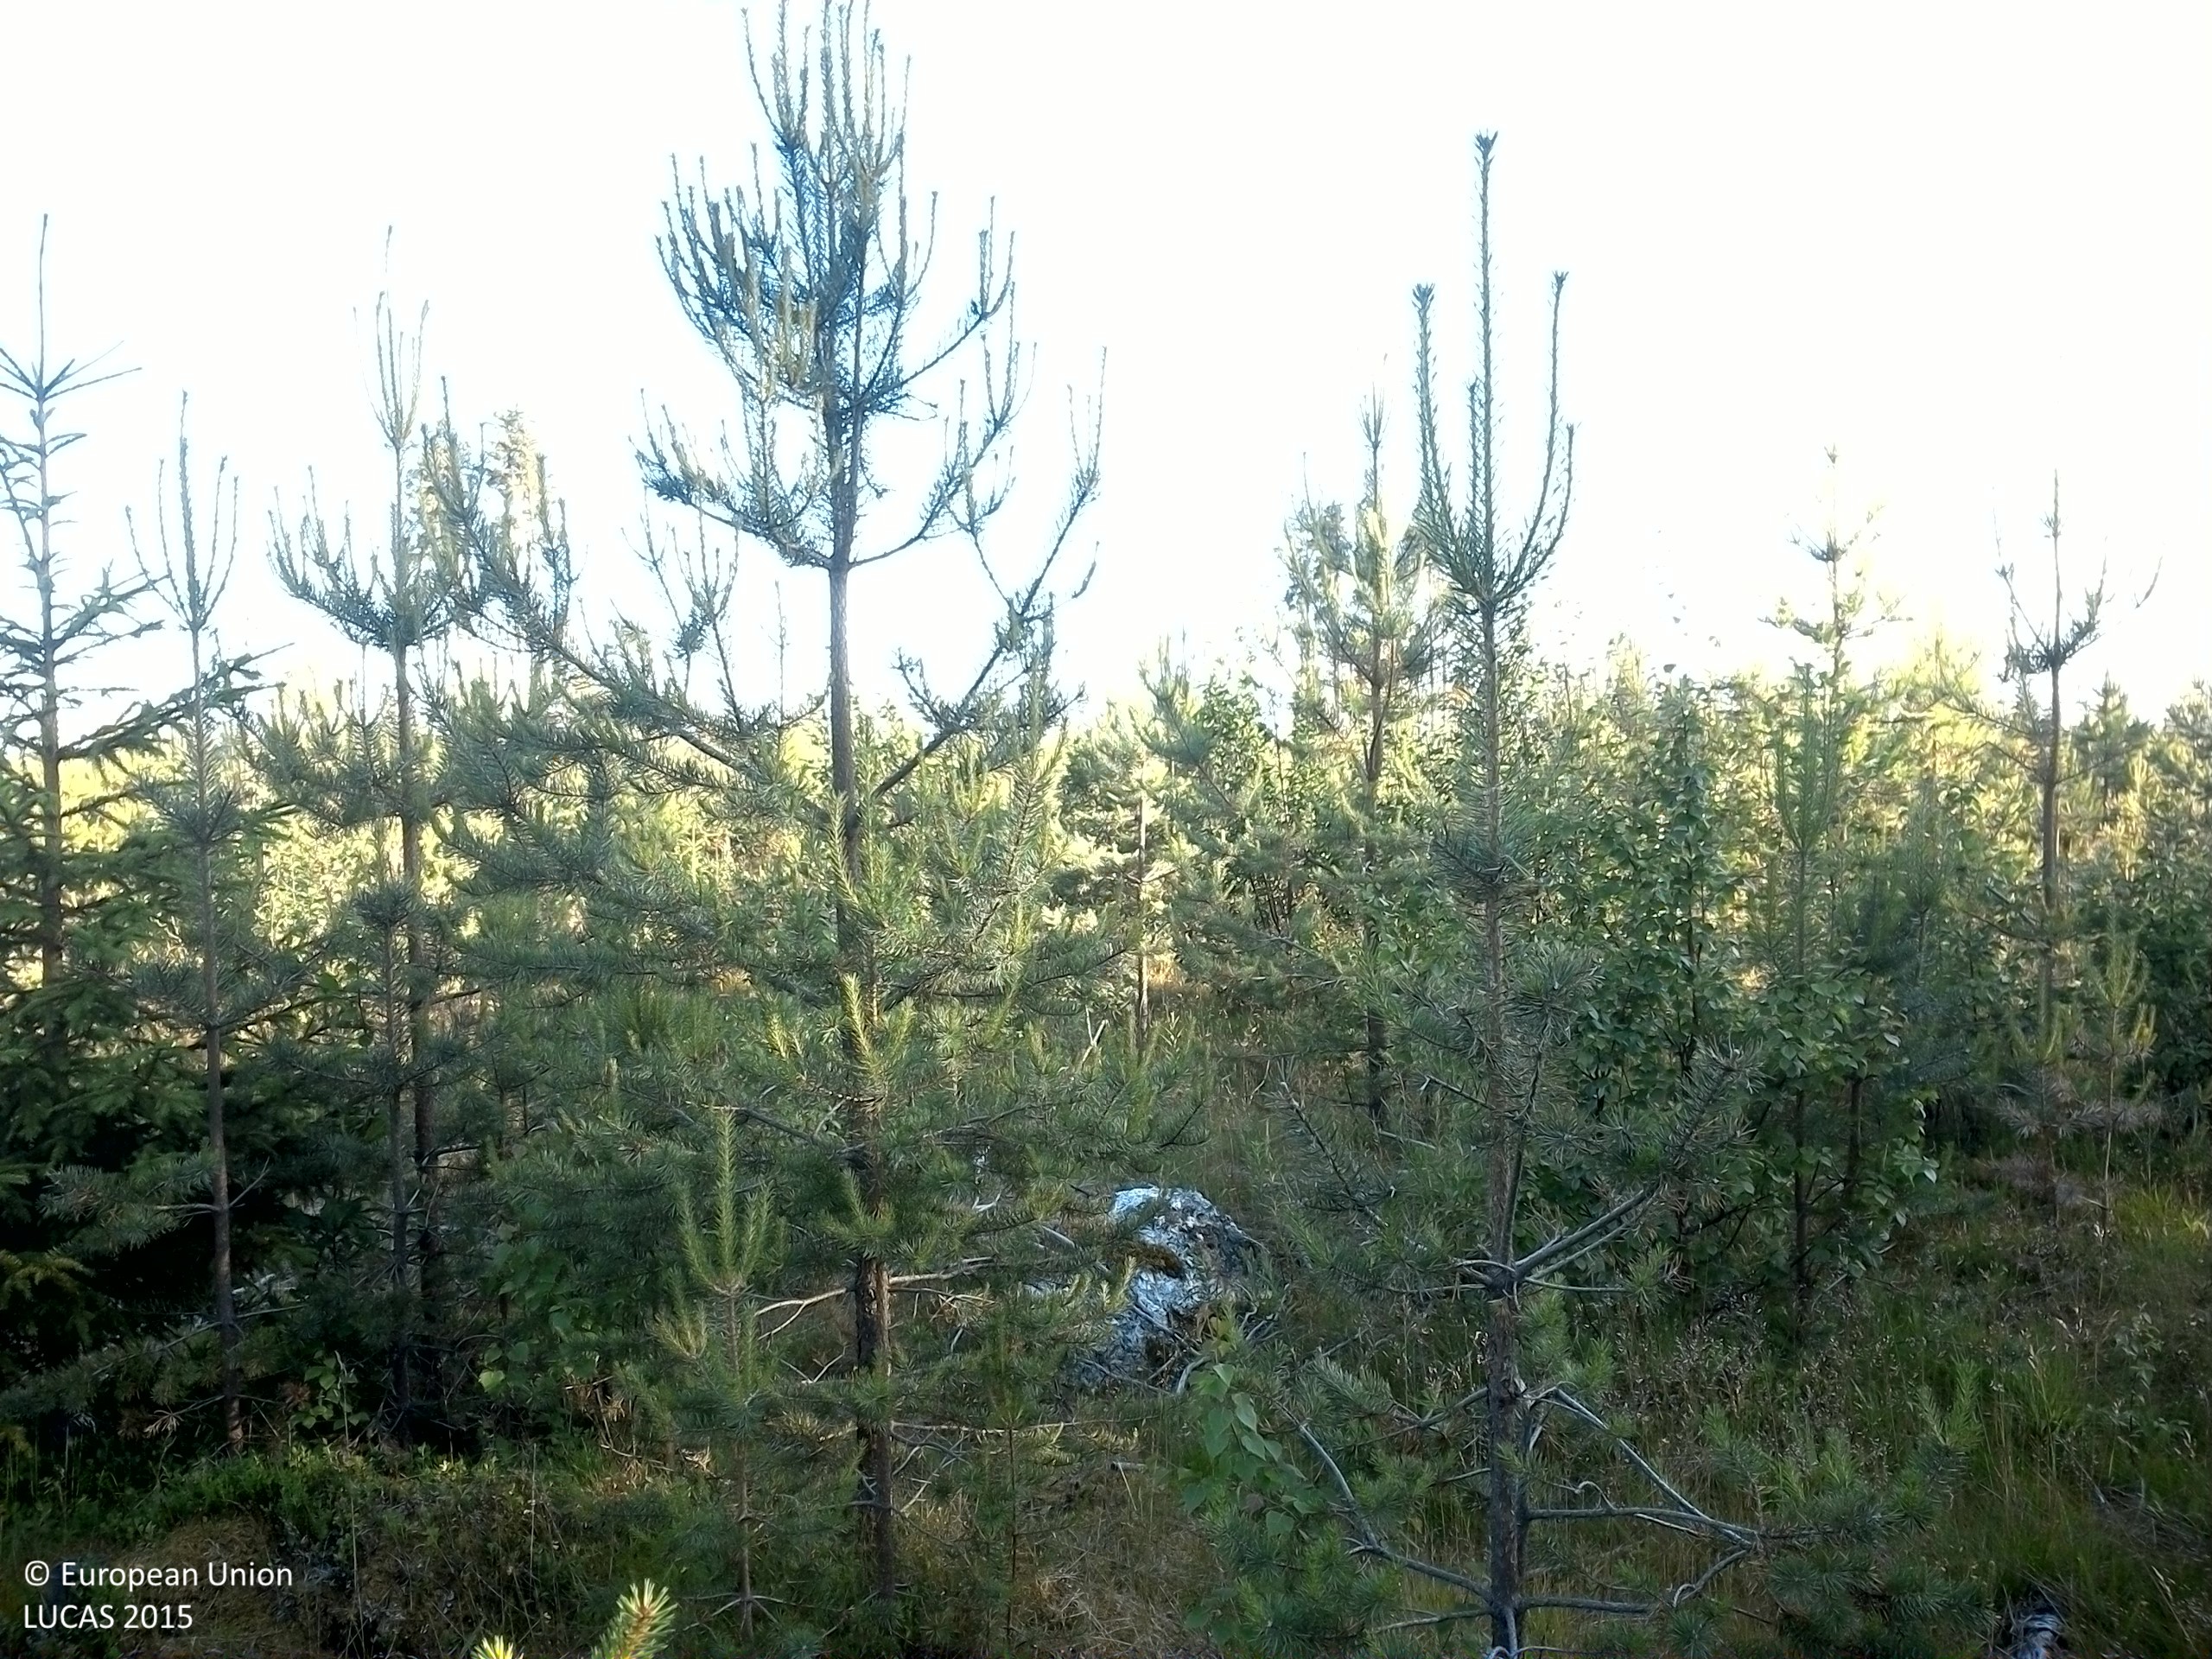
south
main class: Woodland
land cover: Pine dominated mixed woodland
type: boreal forest
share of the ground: 50 - 75 %
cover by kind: coniferous forest trees 45 %, herbaceous plants 20 %, broadleaved forest trees 15 %, shrubs 10 %, lichens and mosses 10 %
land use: Forestry
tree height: < 5 m
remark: Clear cut
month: July
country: SE
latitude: 63.6560
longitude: 17.5472
